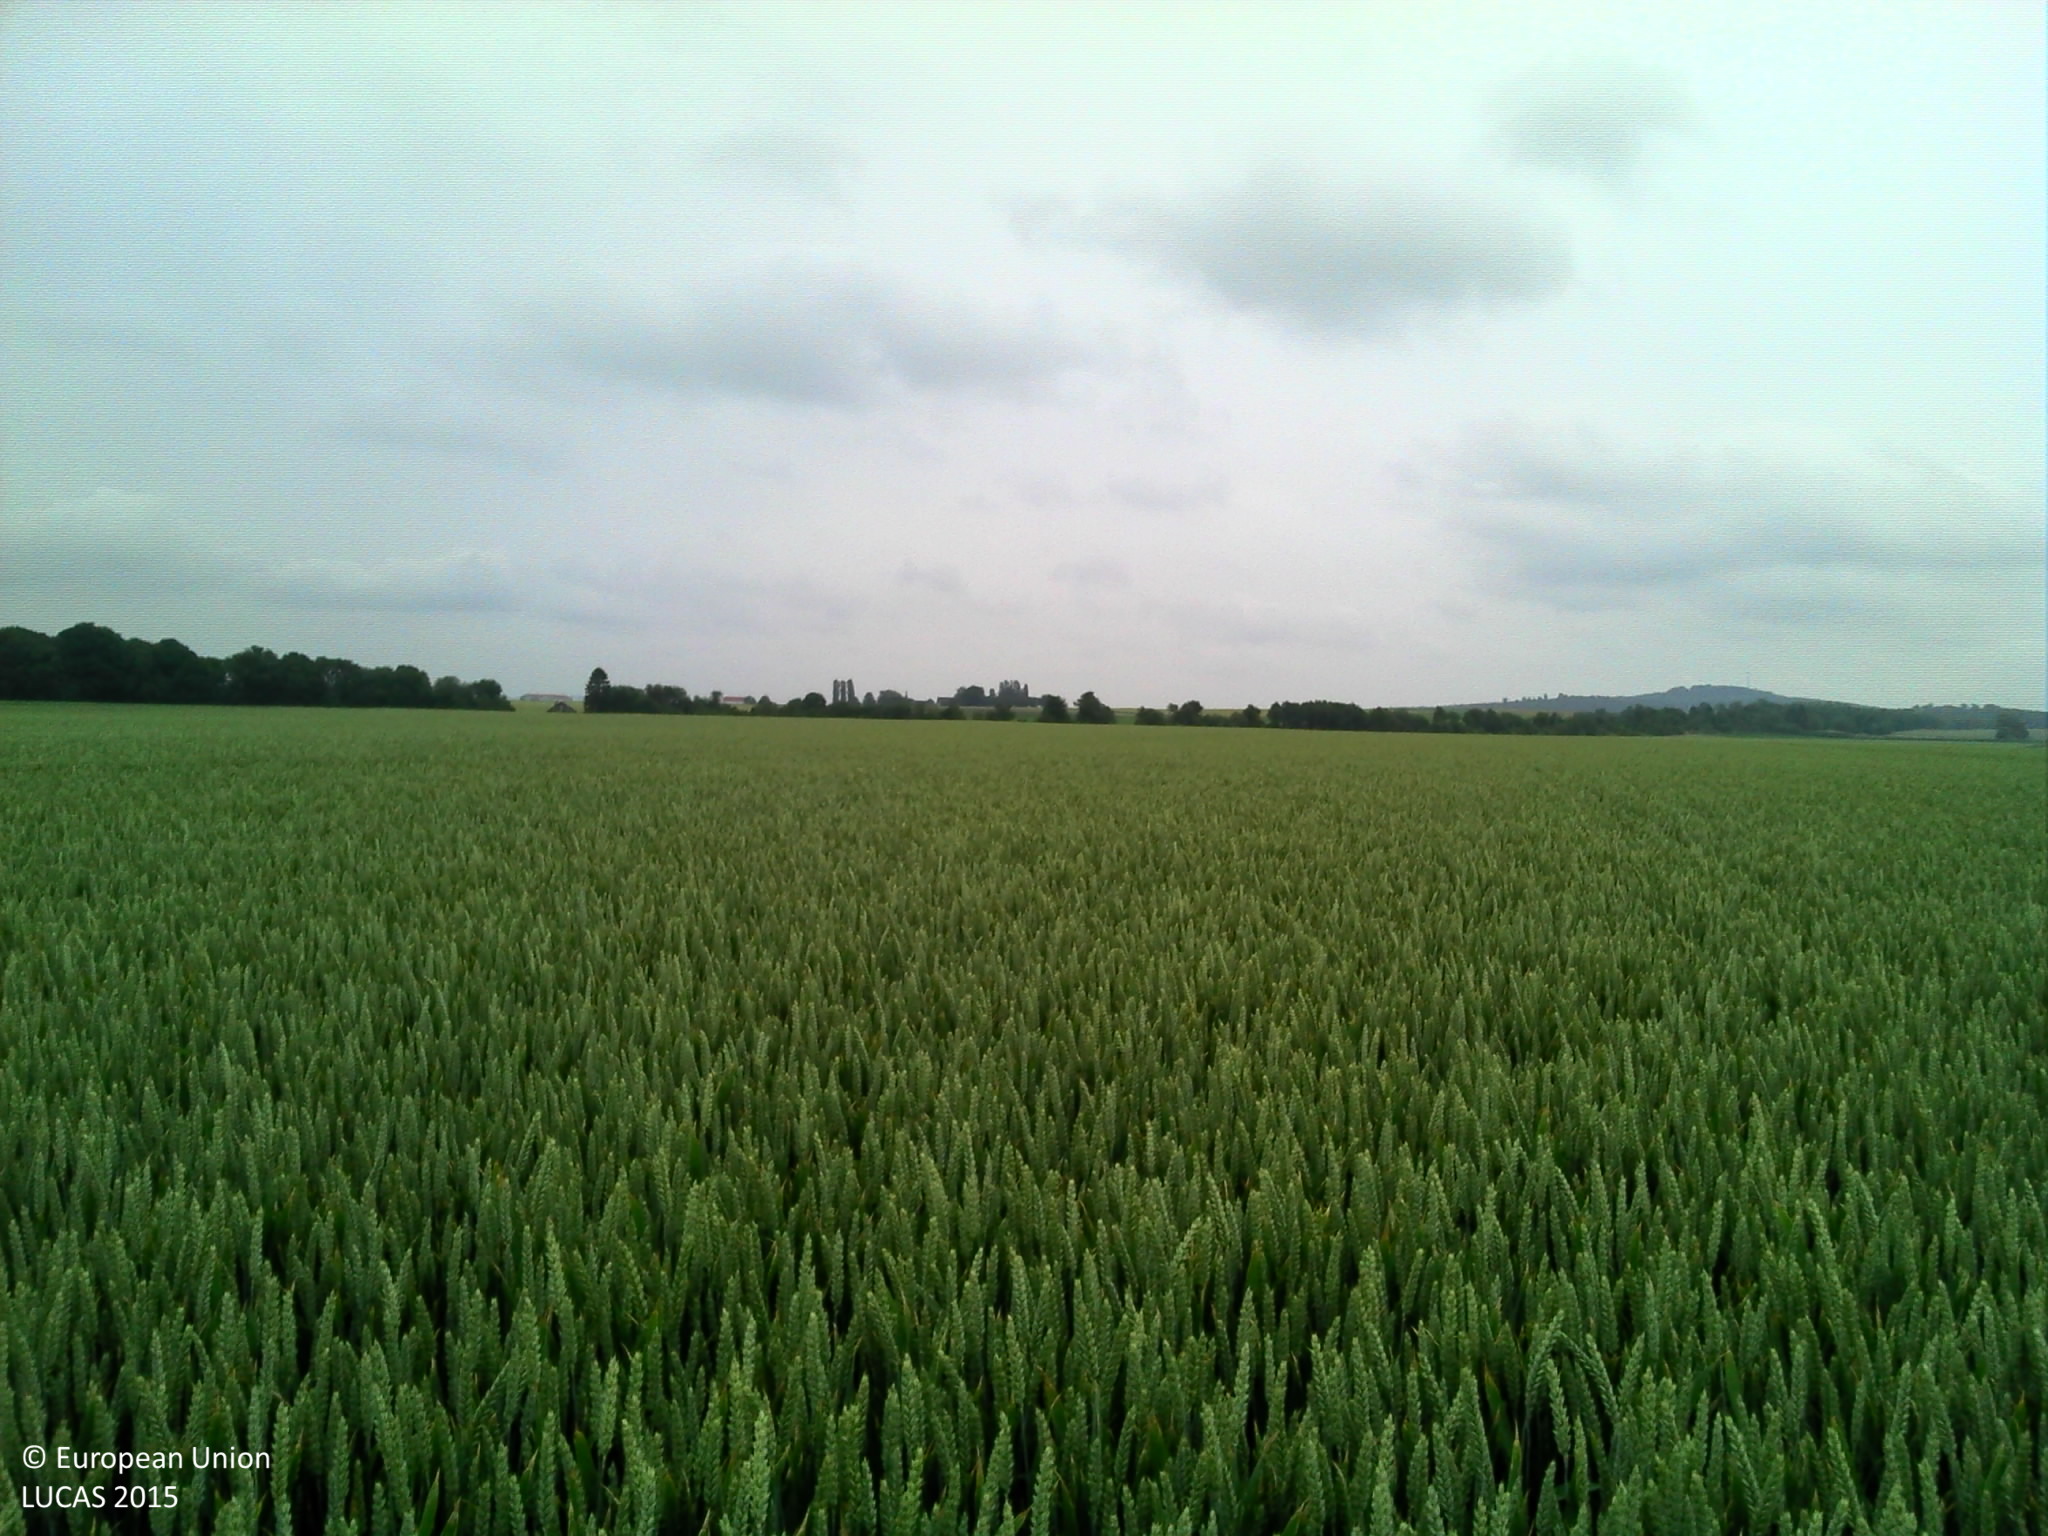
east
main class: Cropland
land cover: Common wheat
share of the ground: > 75 %
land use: Agriculture (excluding fallow land and kitchen gardens)
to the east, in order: Common wheat
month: June
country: FR
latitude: 49.3150
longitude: 2.9336
